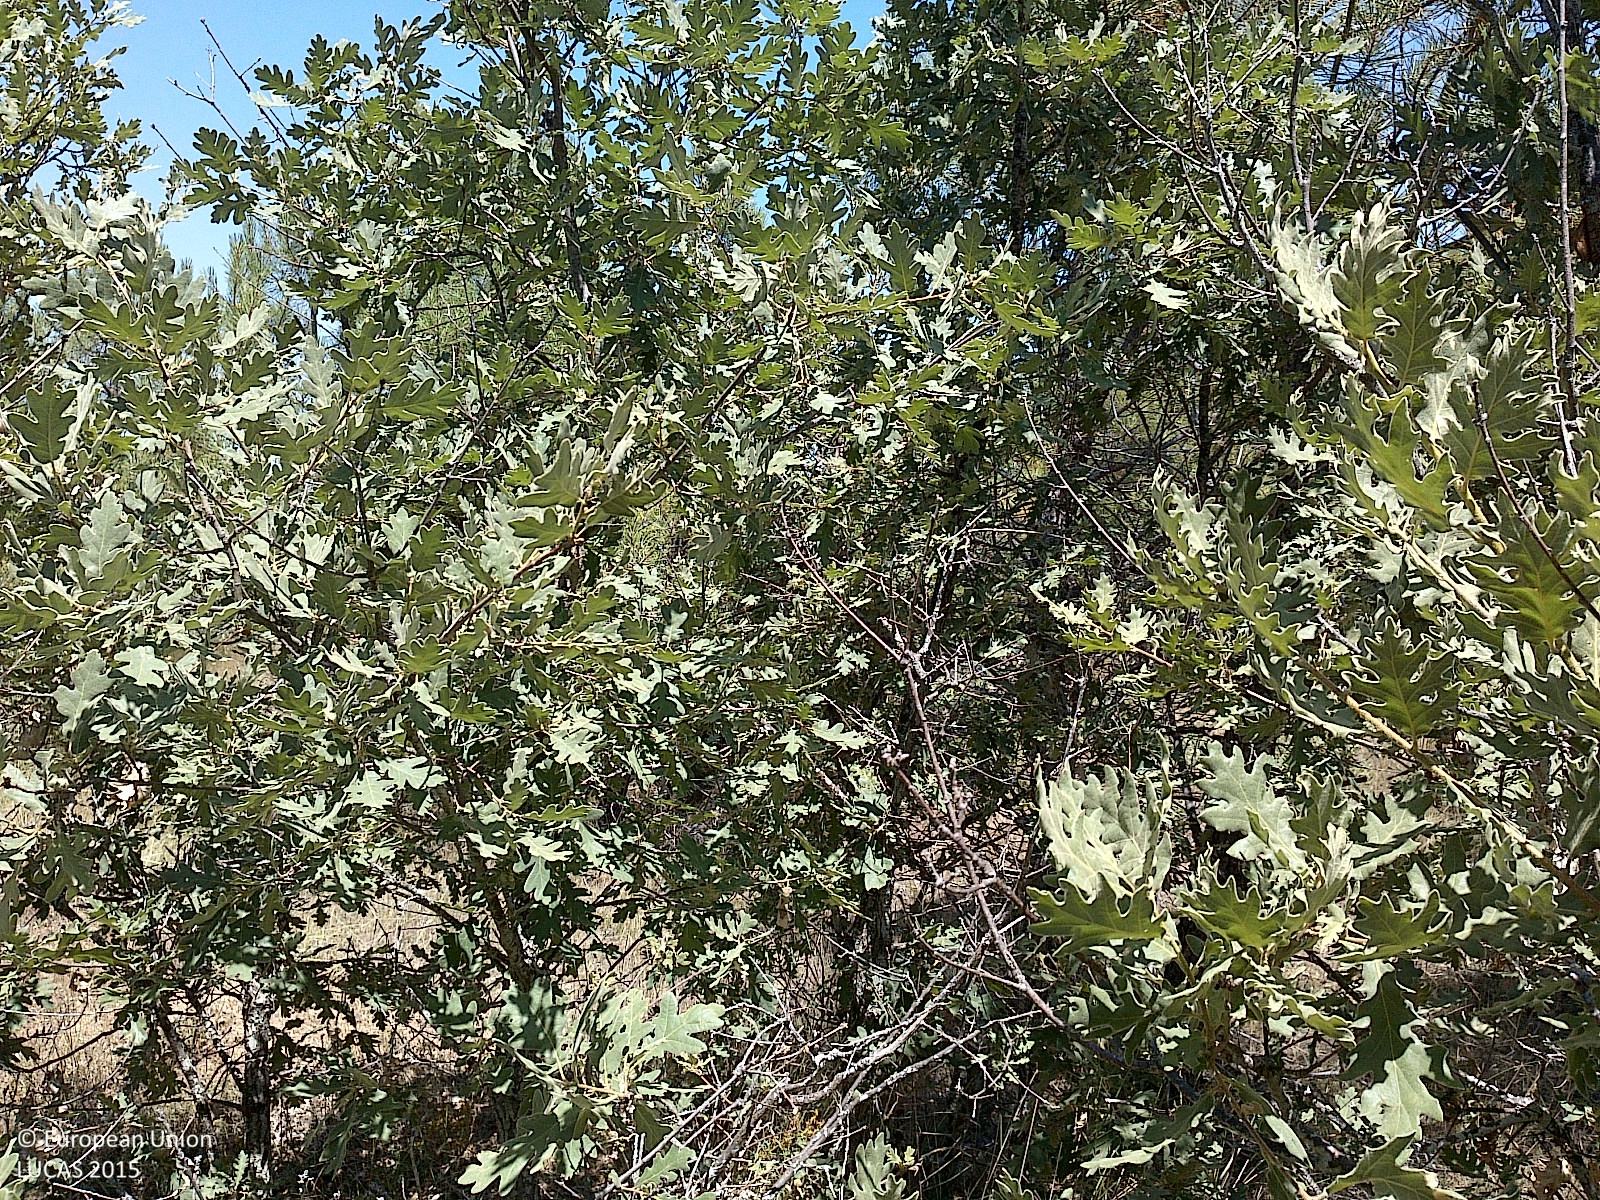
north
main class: Woodland
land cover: Pine dominated mixed woodland
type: coniferous forest of the mediterranean region
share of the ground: 50 - 75 %
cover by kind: coniferous forest trees 50 %, herbaceous plants 25 %, broadleaved forest trees 20 %, unconsolidated bare surface 5 %
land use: Forestry
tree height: < 5 m
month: July
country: ES
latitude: 41.6963
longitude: -2.0364
